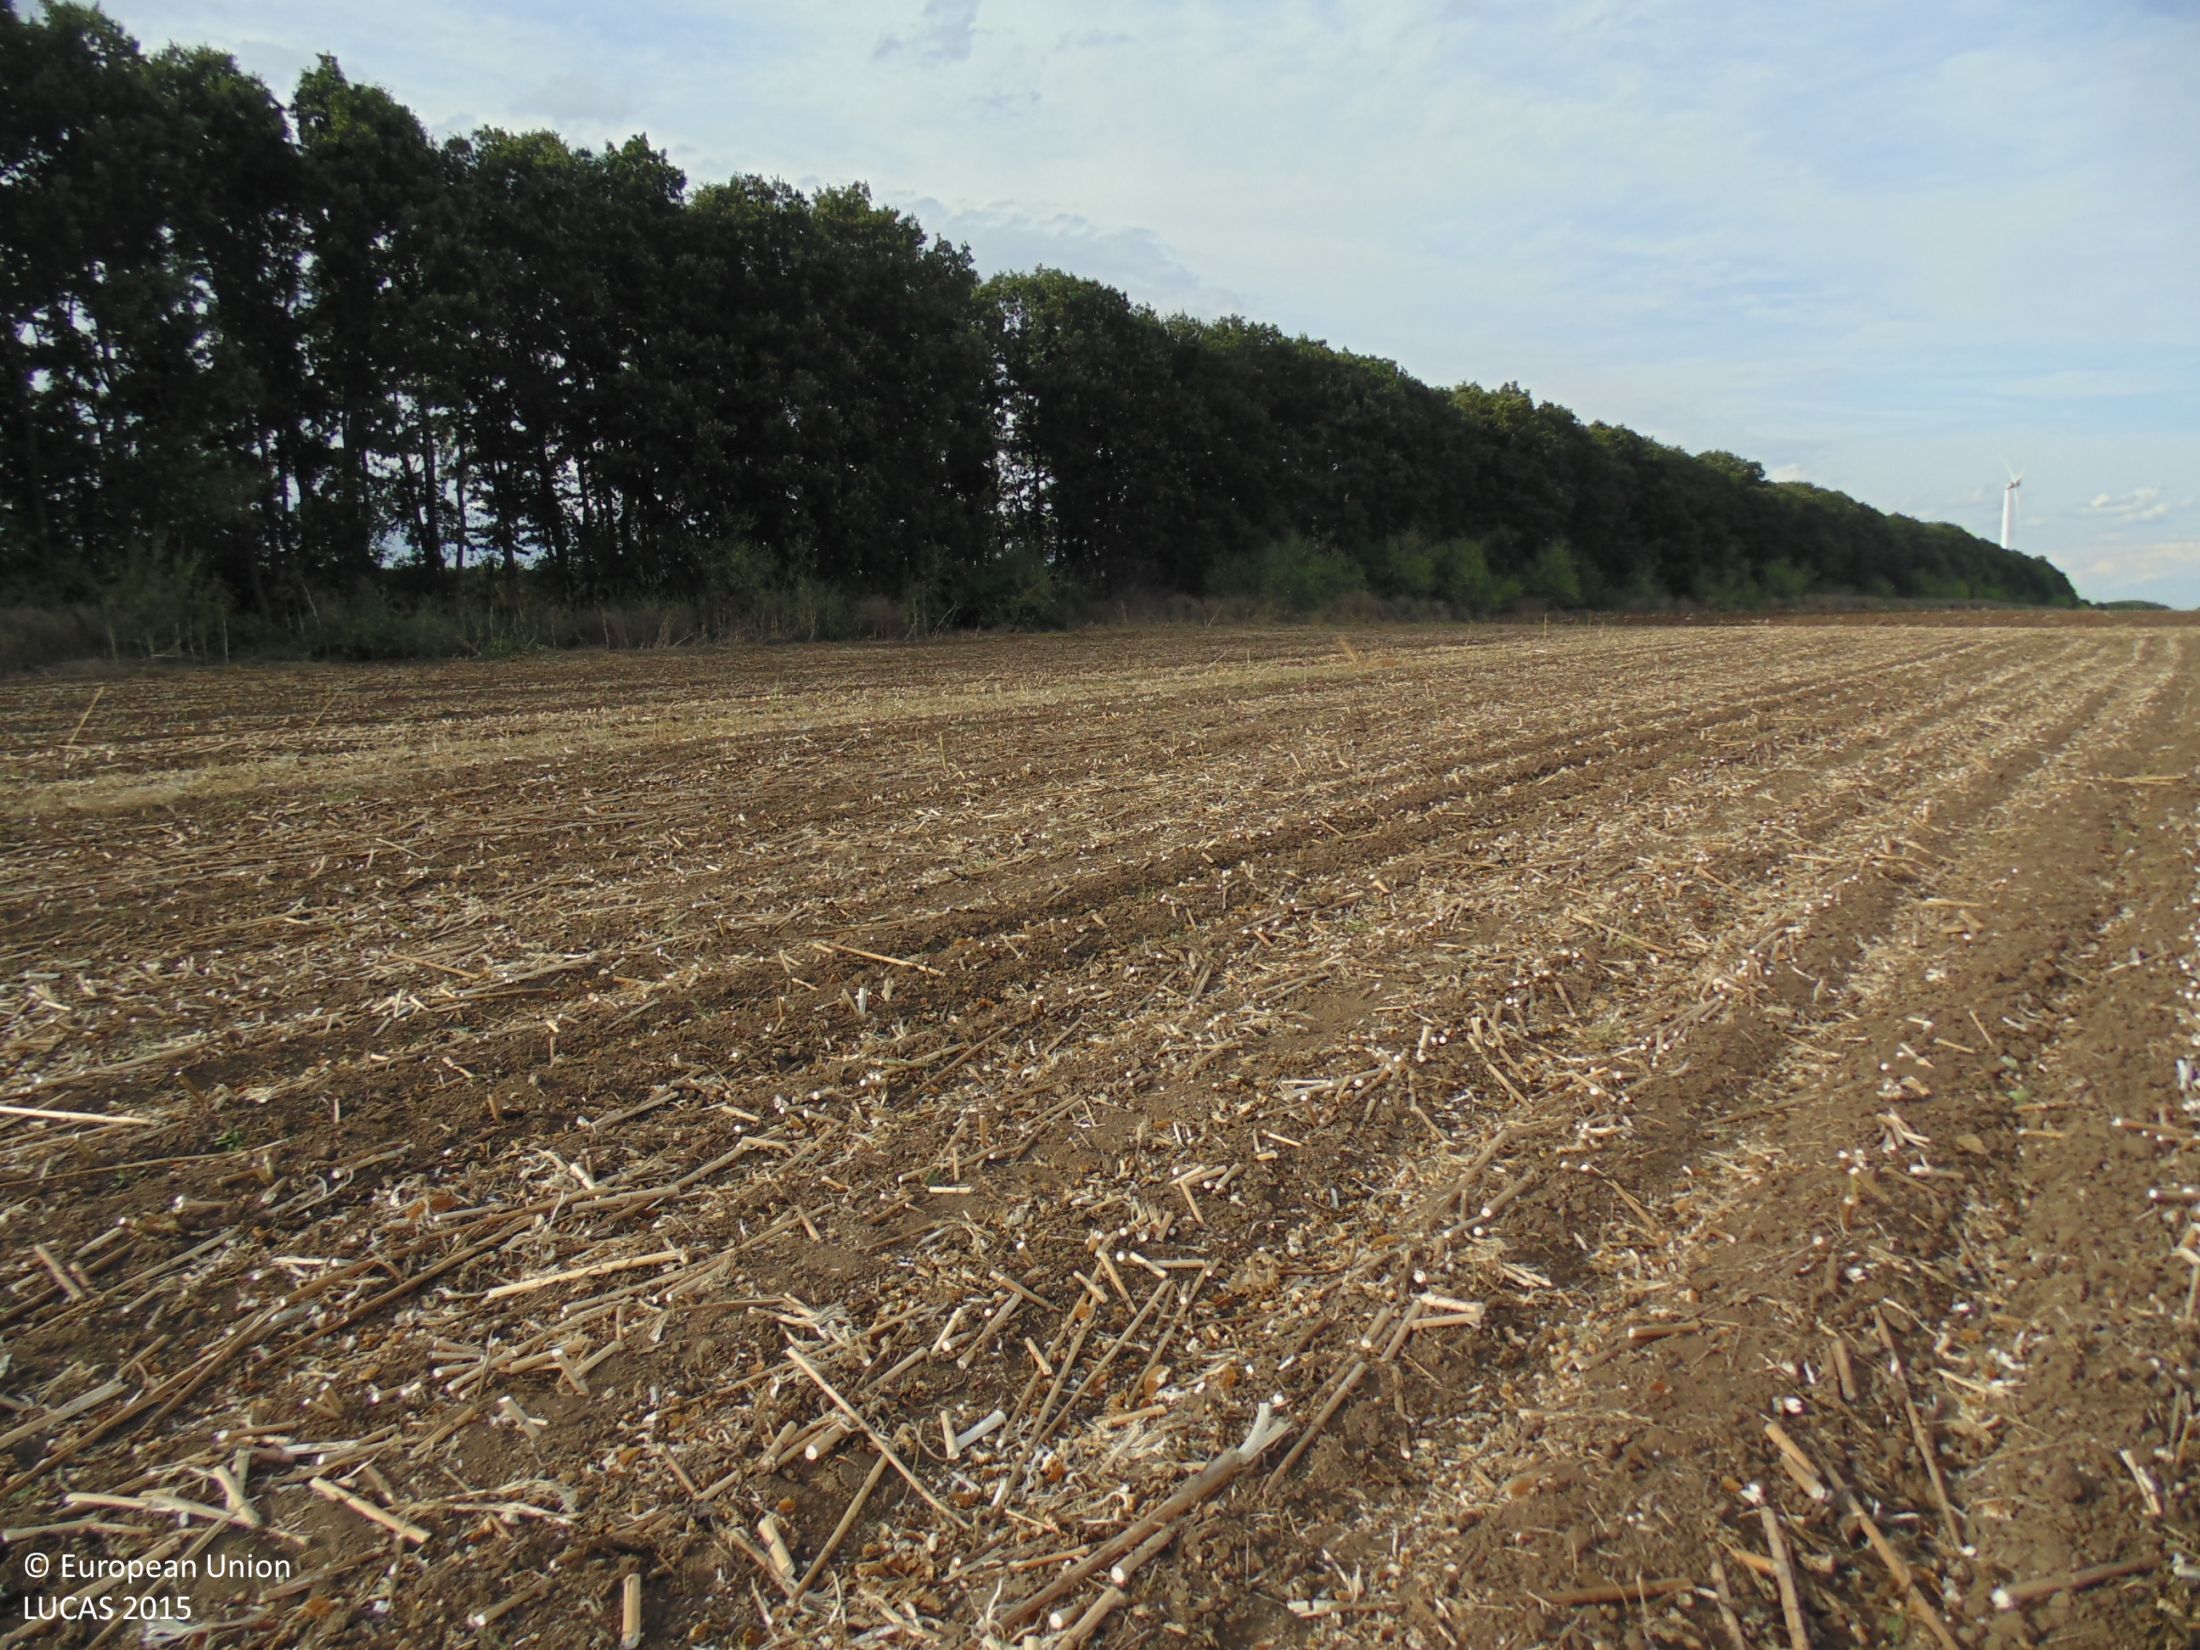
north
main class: Cropland
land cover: Sunflower
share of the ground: < 10 %
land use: Agriculture (excluding fallow land and kitchen gardens)
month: September
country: BG
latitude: 43.4956
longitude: 28.4240
